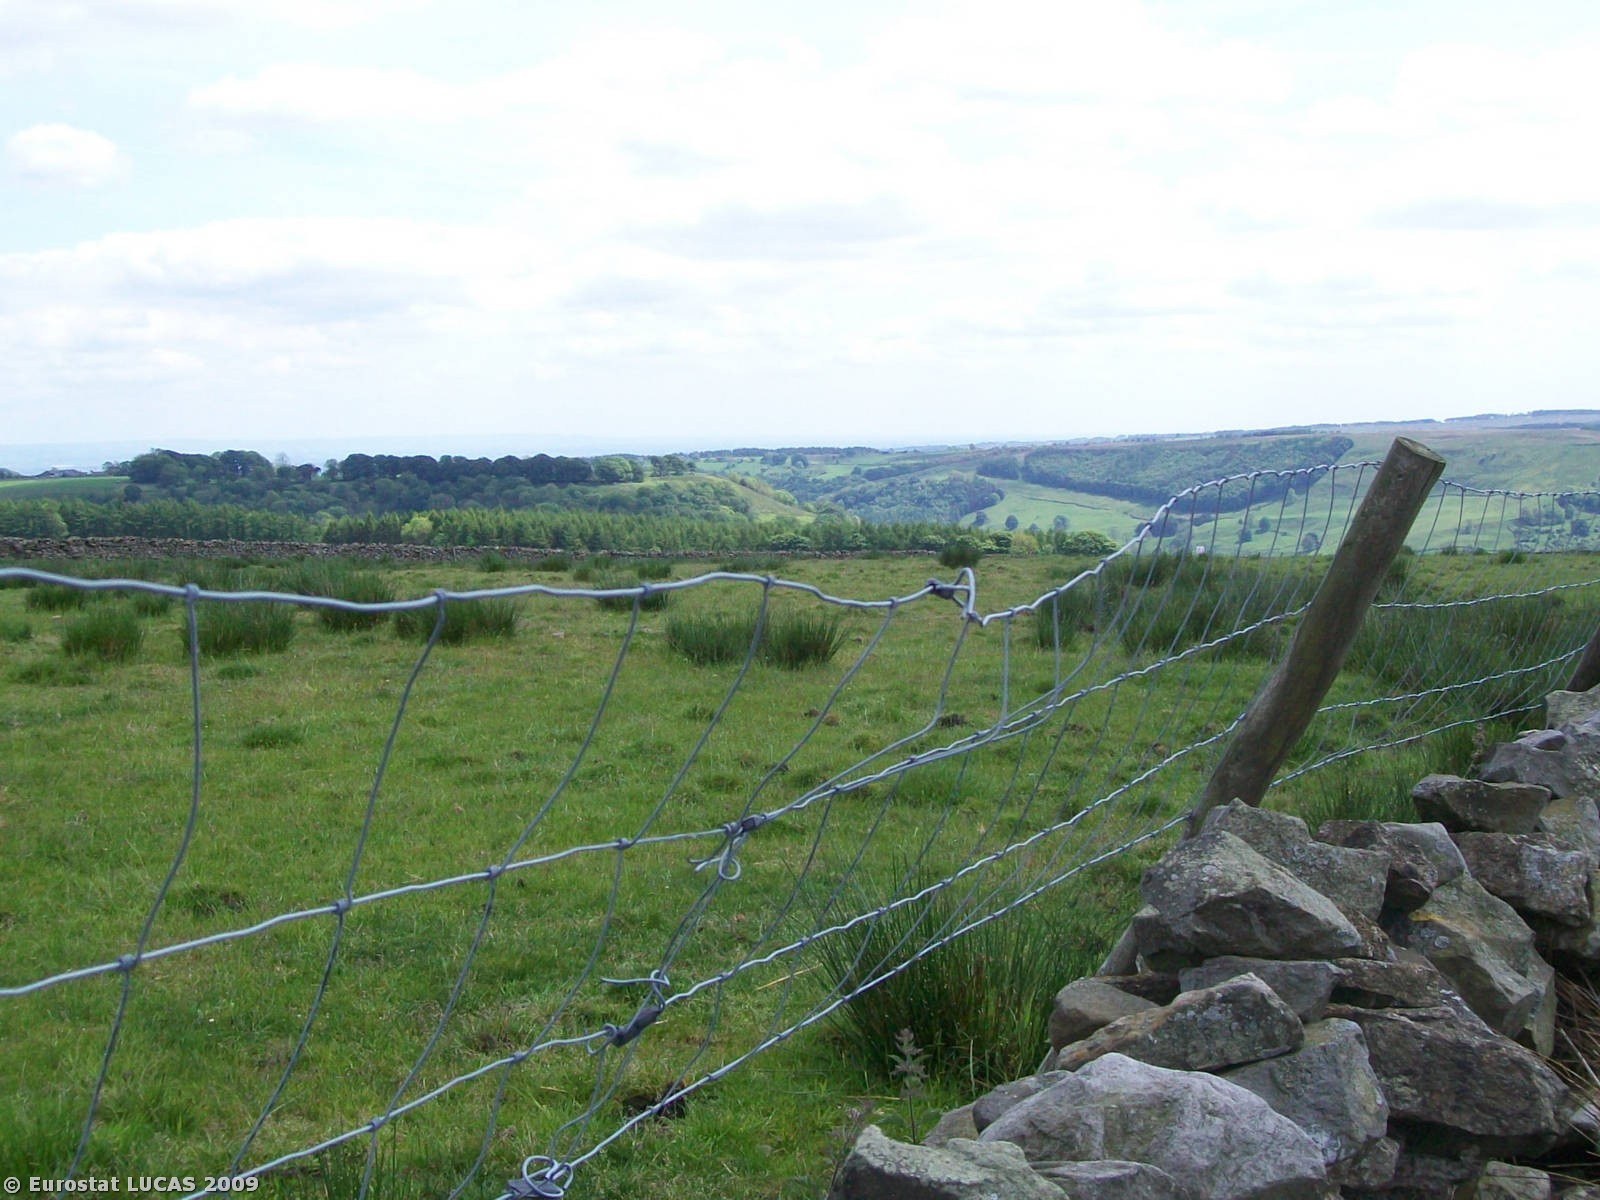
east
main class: Shrubland
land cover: Shrubland without tree cover
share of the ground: > 75 %
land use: Fallow land
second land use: Community services
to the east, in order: Shrubland without tree cover
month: June
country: GB
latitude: 54.4184
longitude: -1.8427
